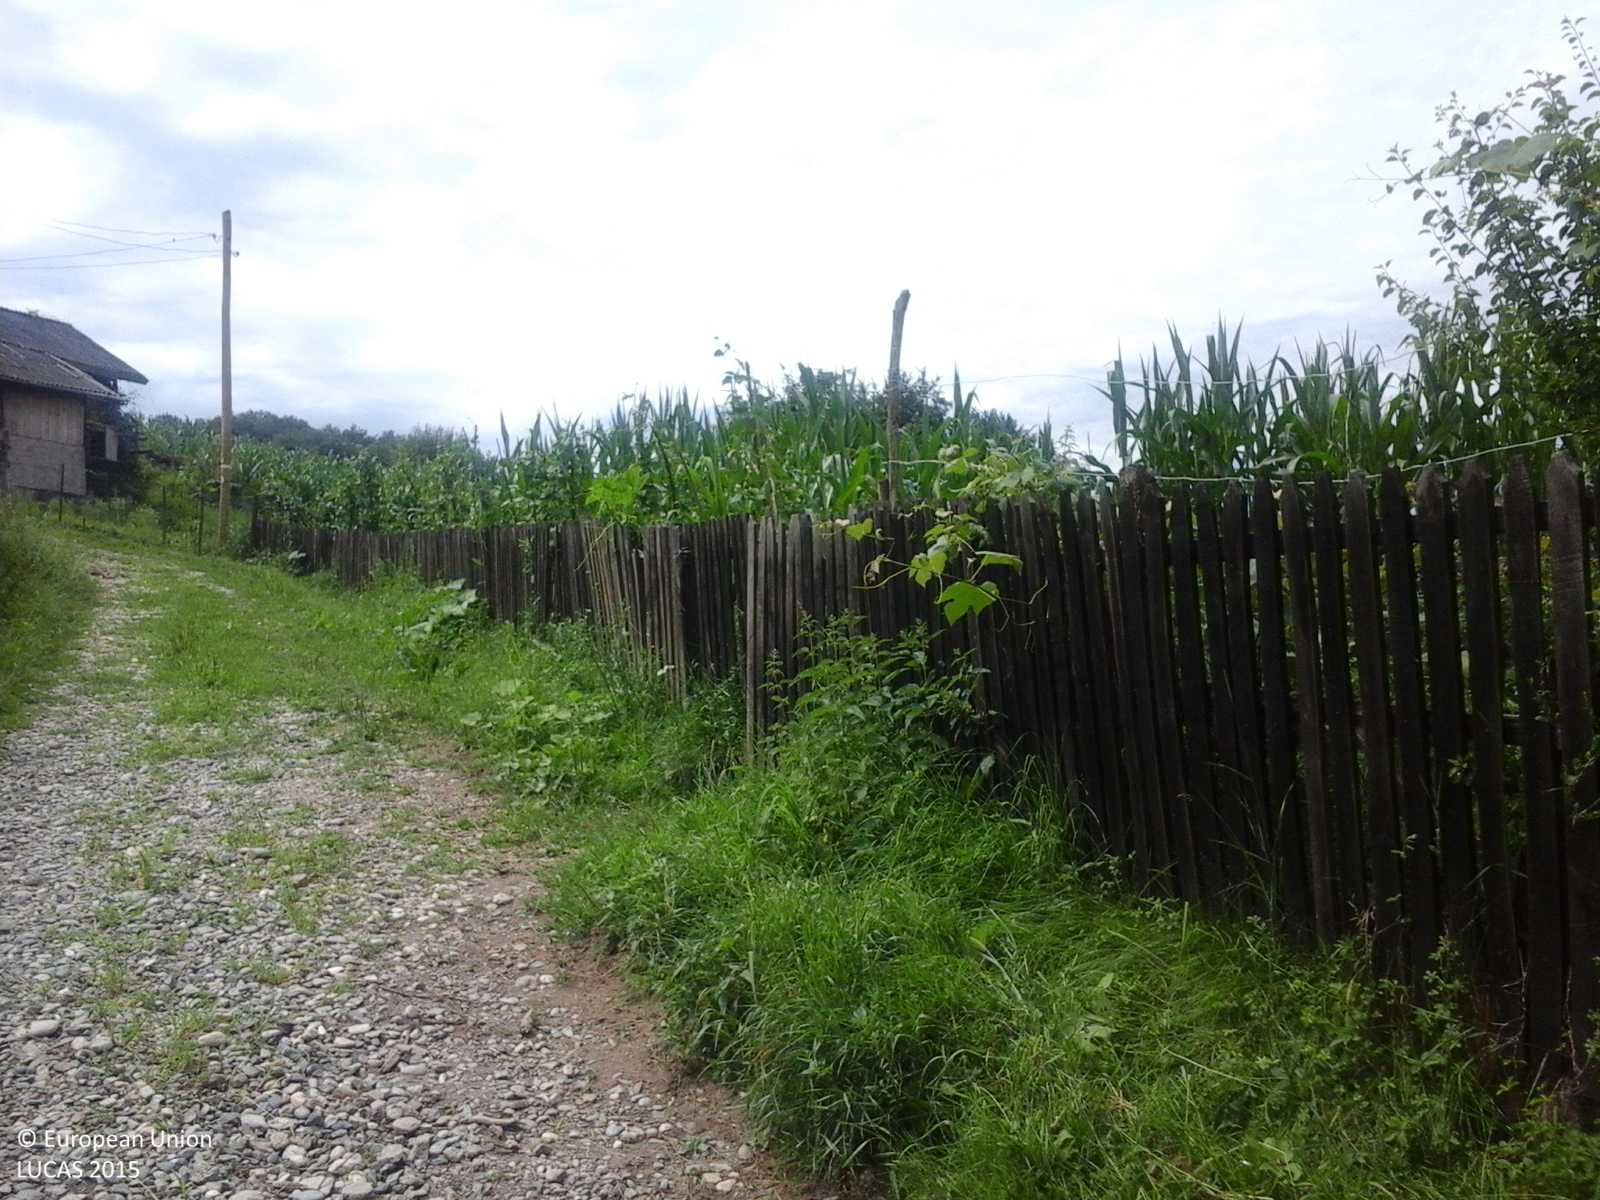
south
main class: Cropland
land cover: Apple fruit
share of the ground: > 75 %
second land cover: Grassland without tree/shrub cover
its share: > 75 %
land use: Agriculture (excluding fallow land and kitchen gardens)
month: July
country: RO
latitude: 45.1995
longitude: 24.7081
